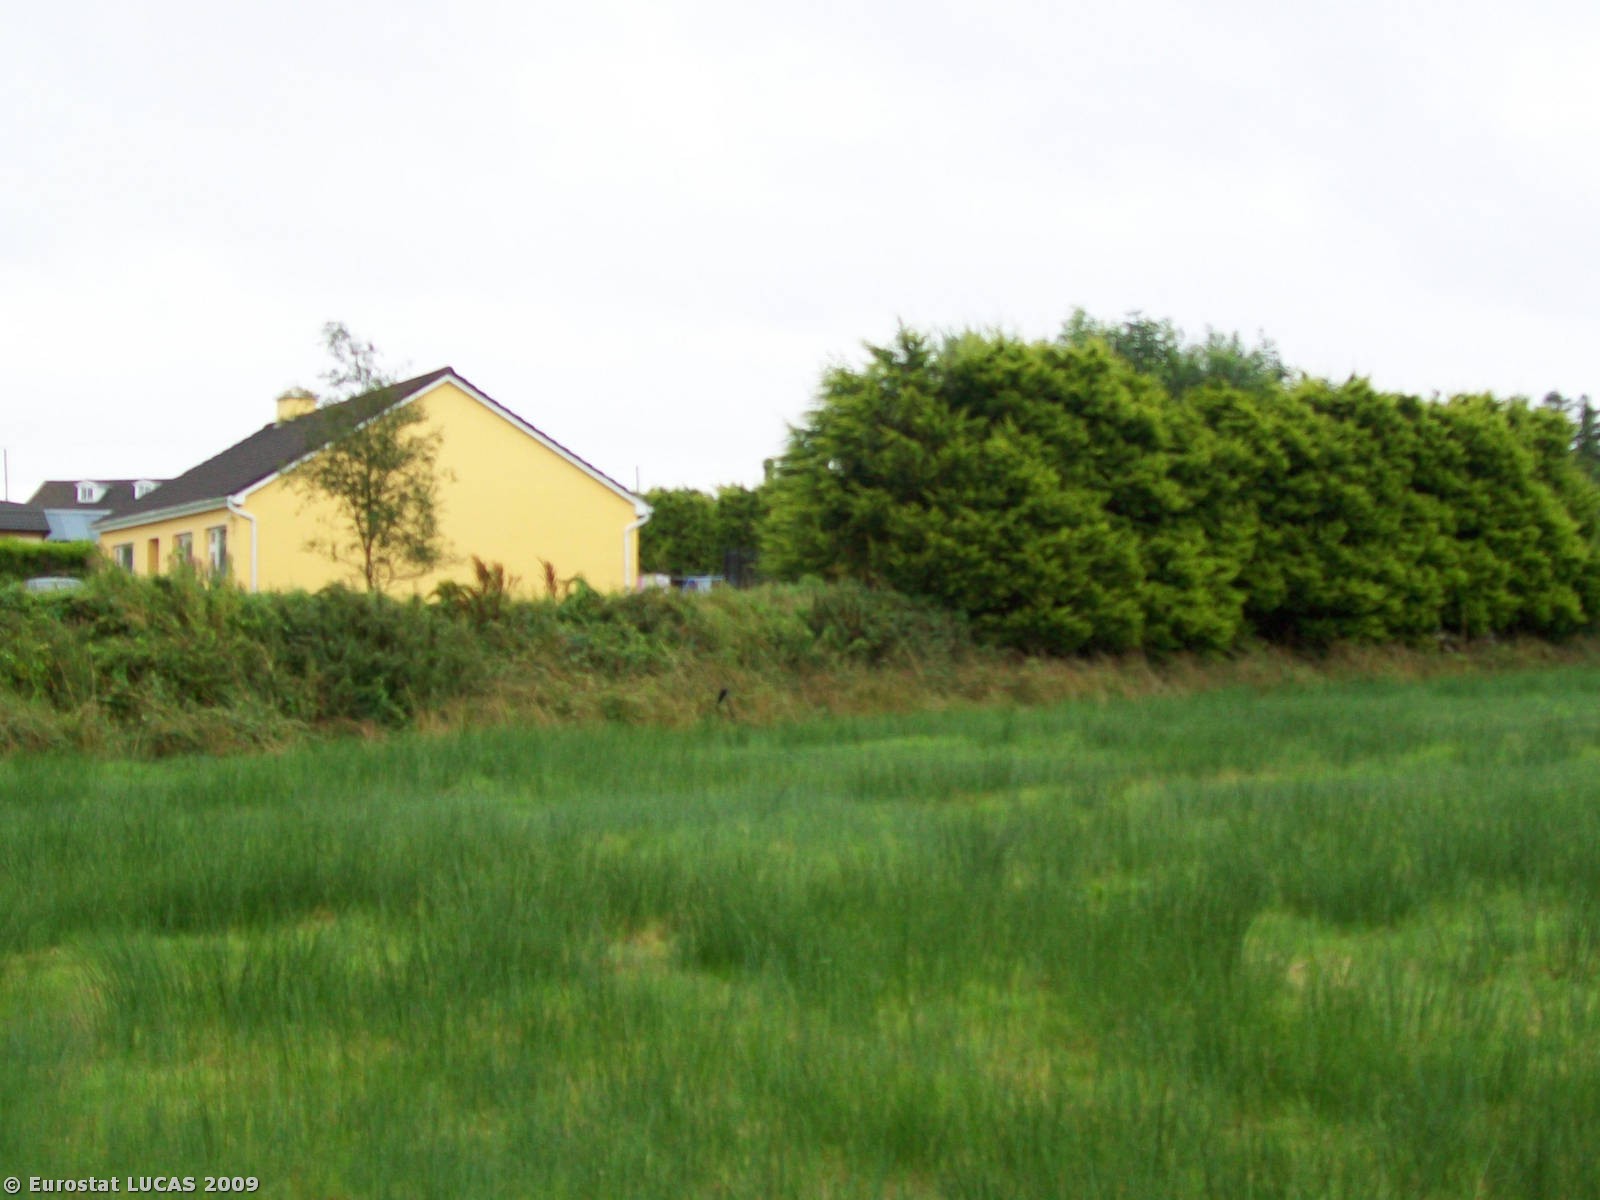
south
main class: Grassland
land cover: Grassland without tree/shrub cover
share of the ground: > 75 %
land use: Agriculture (excluding fallow land and kitchen gardens)
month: August
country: IE
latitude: 52.8338
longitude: -9.1442
